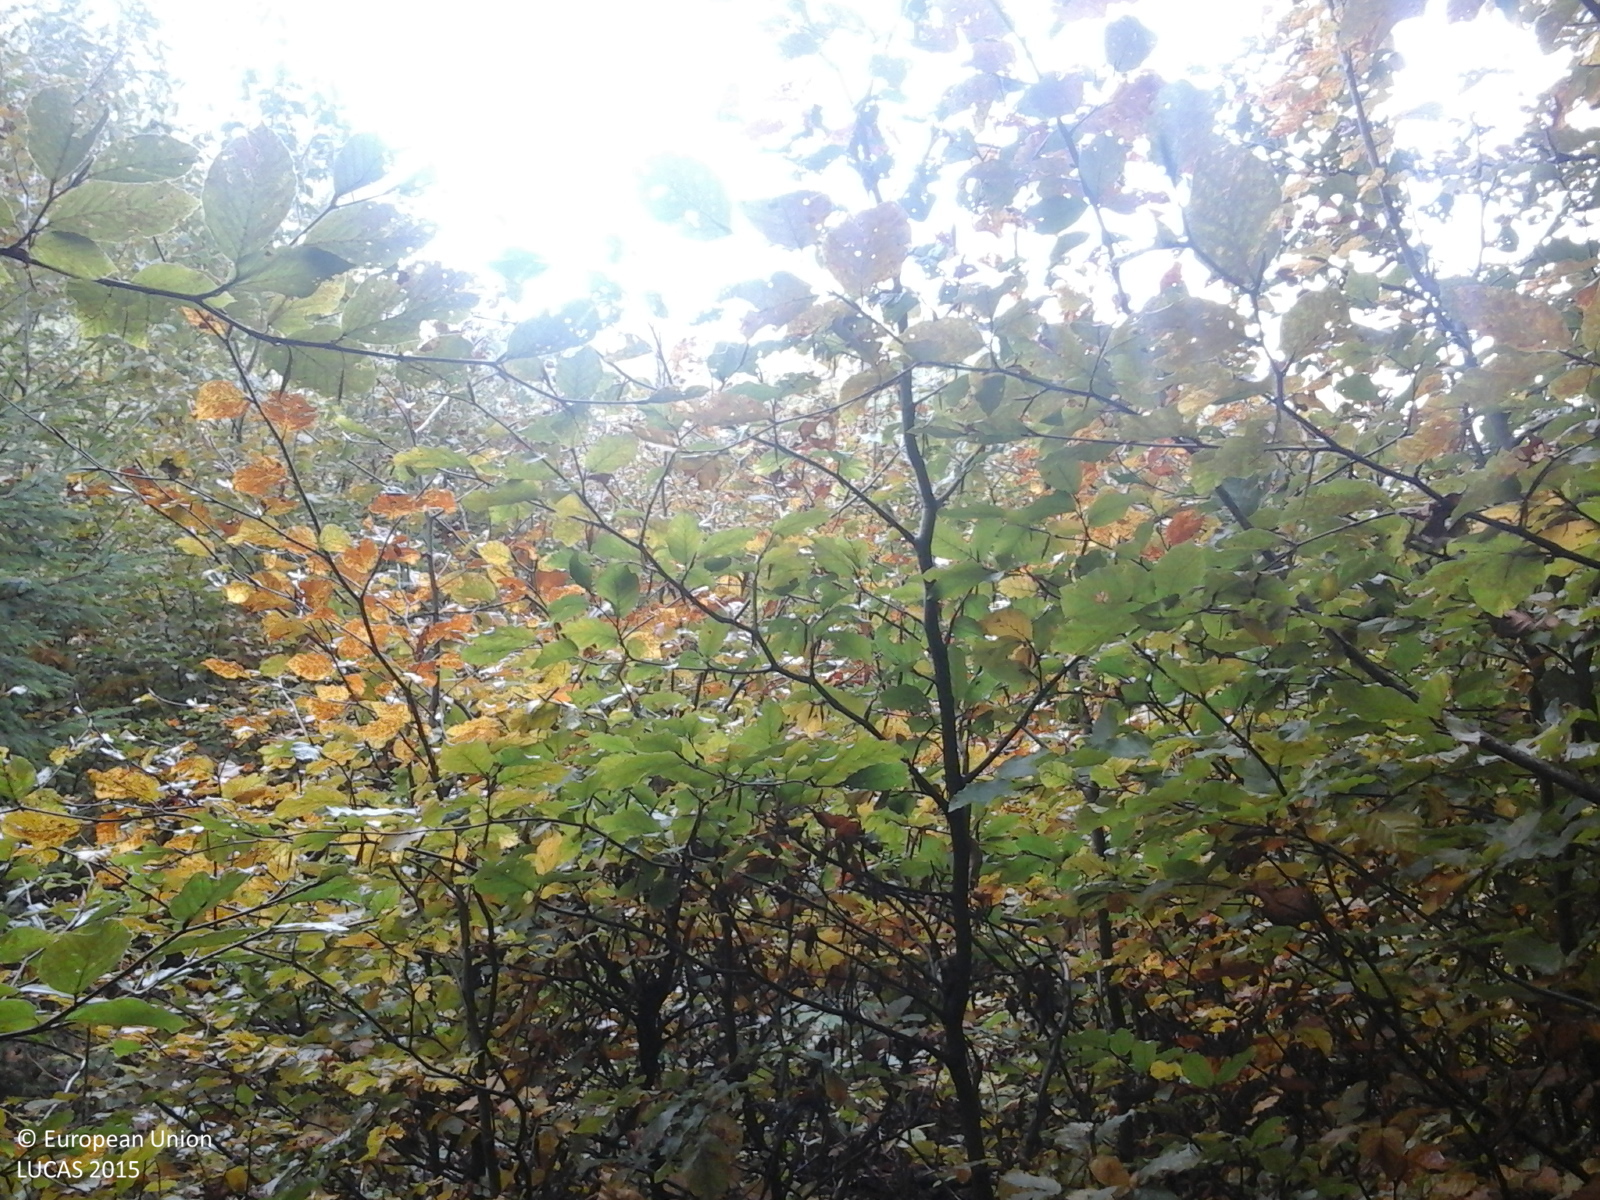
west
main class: Woodland
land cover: Other mixed woodland
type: alpine coniferous forest
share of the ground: > 75 %
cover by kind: coniferous forest trees 60 %, broadleaved forest trees 40 %
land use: Forestry
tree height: > 5 m
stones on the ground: 10 - 25 %
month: October
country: RO
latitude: 46.5507
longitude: 25.2455
